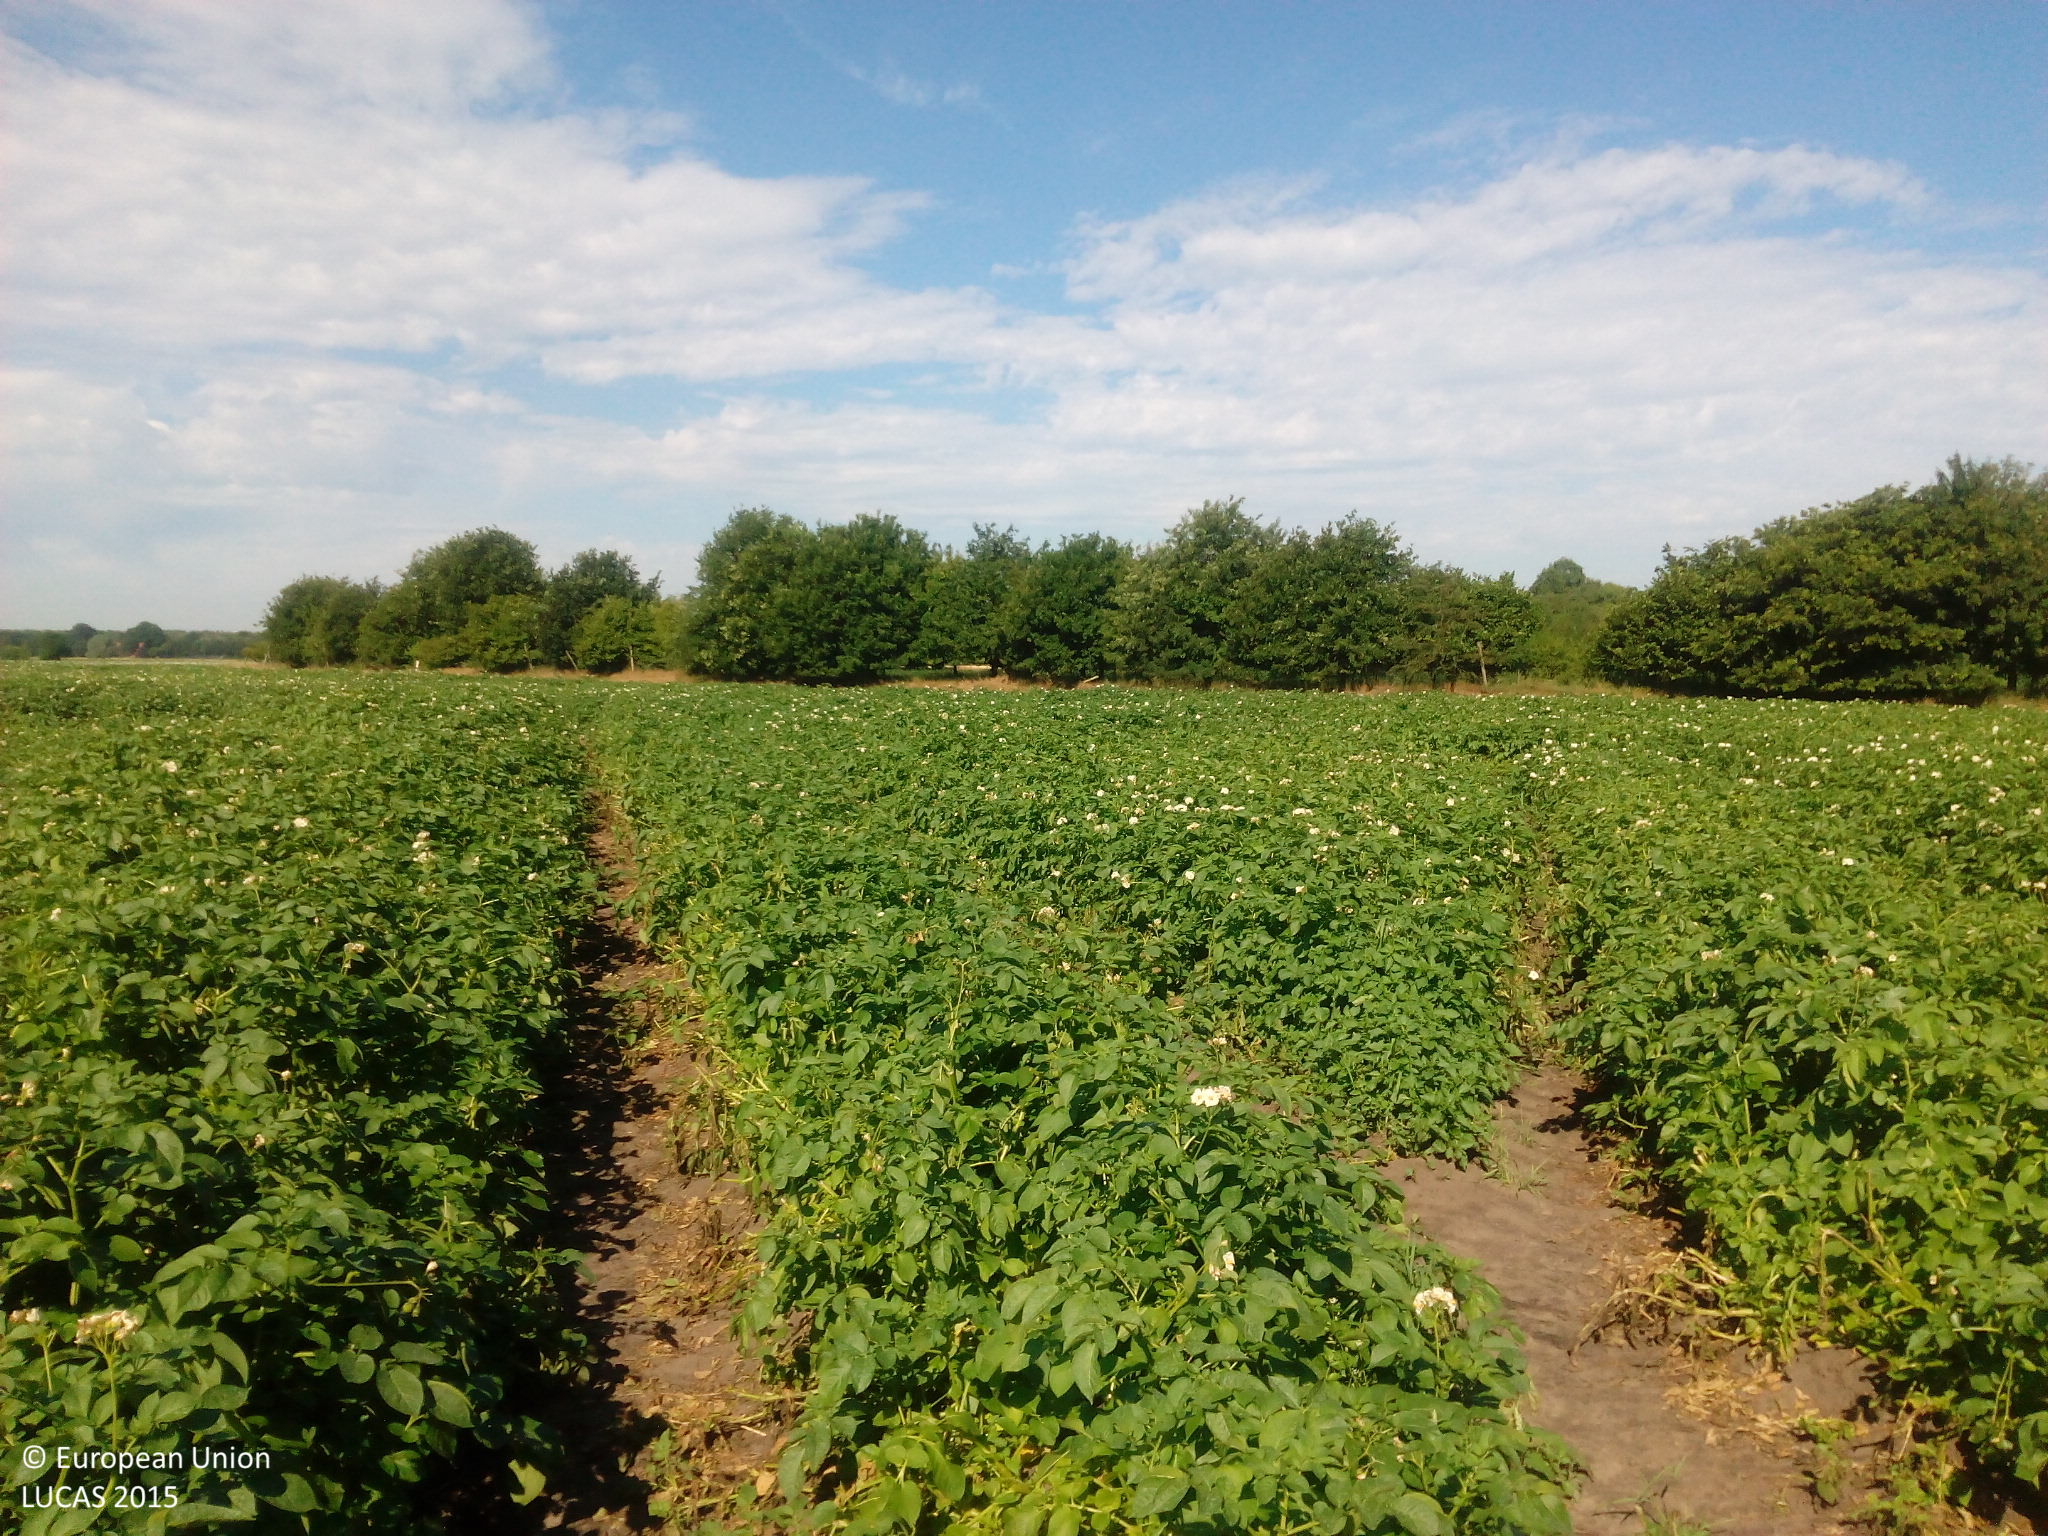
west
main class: Cropland
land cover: Potatoes
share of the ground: > 75 %
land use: Agriculture (excluding fallow land and kitchen gardens)
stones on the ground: < 10 %
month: July
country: DE
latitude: 52.7089
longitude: 7.4102
